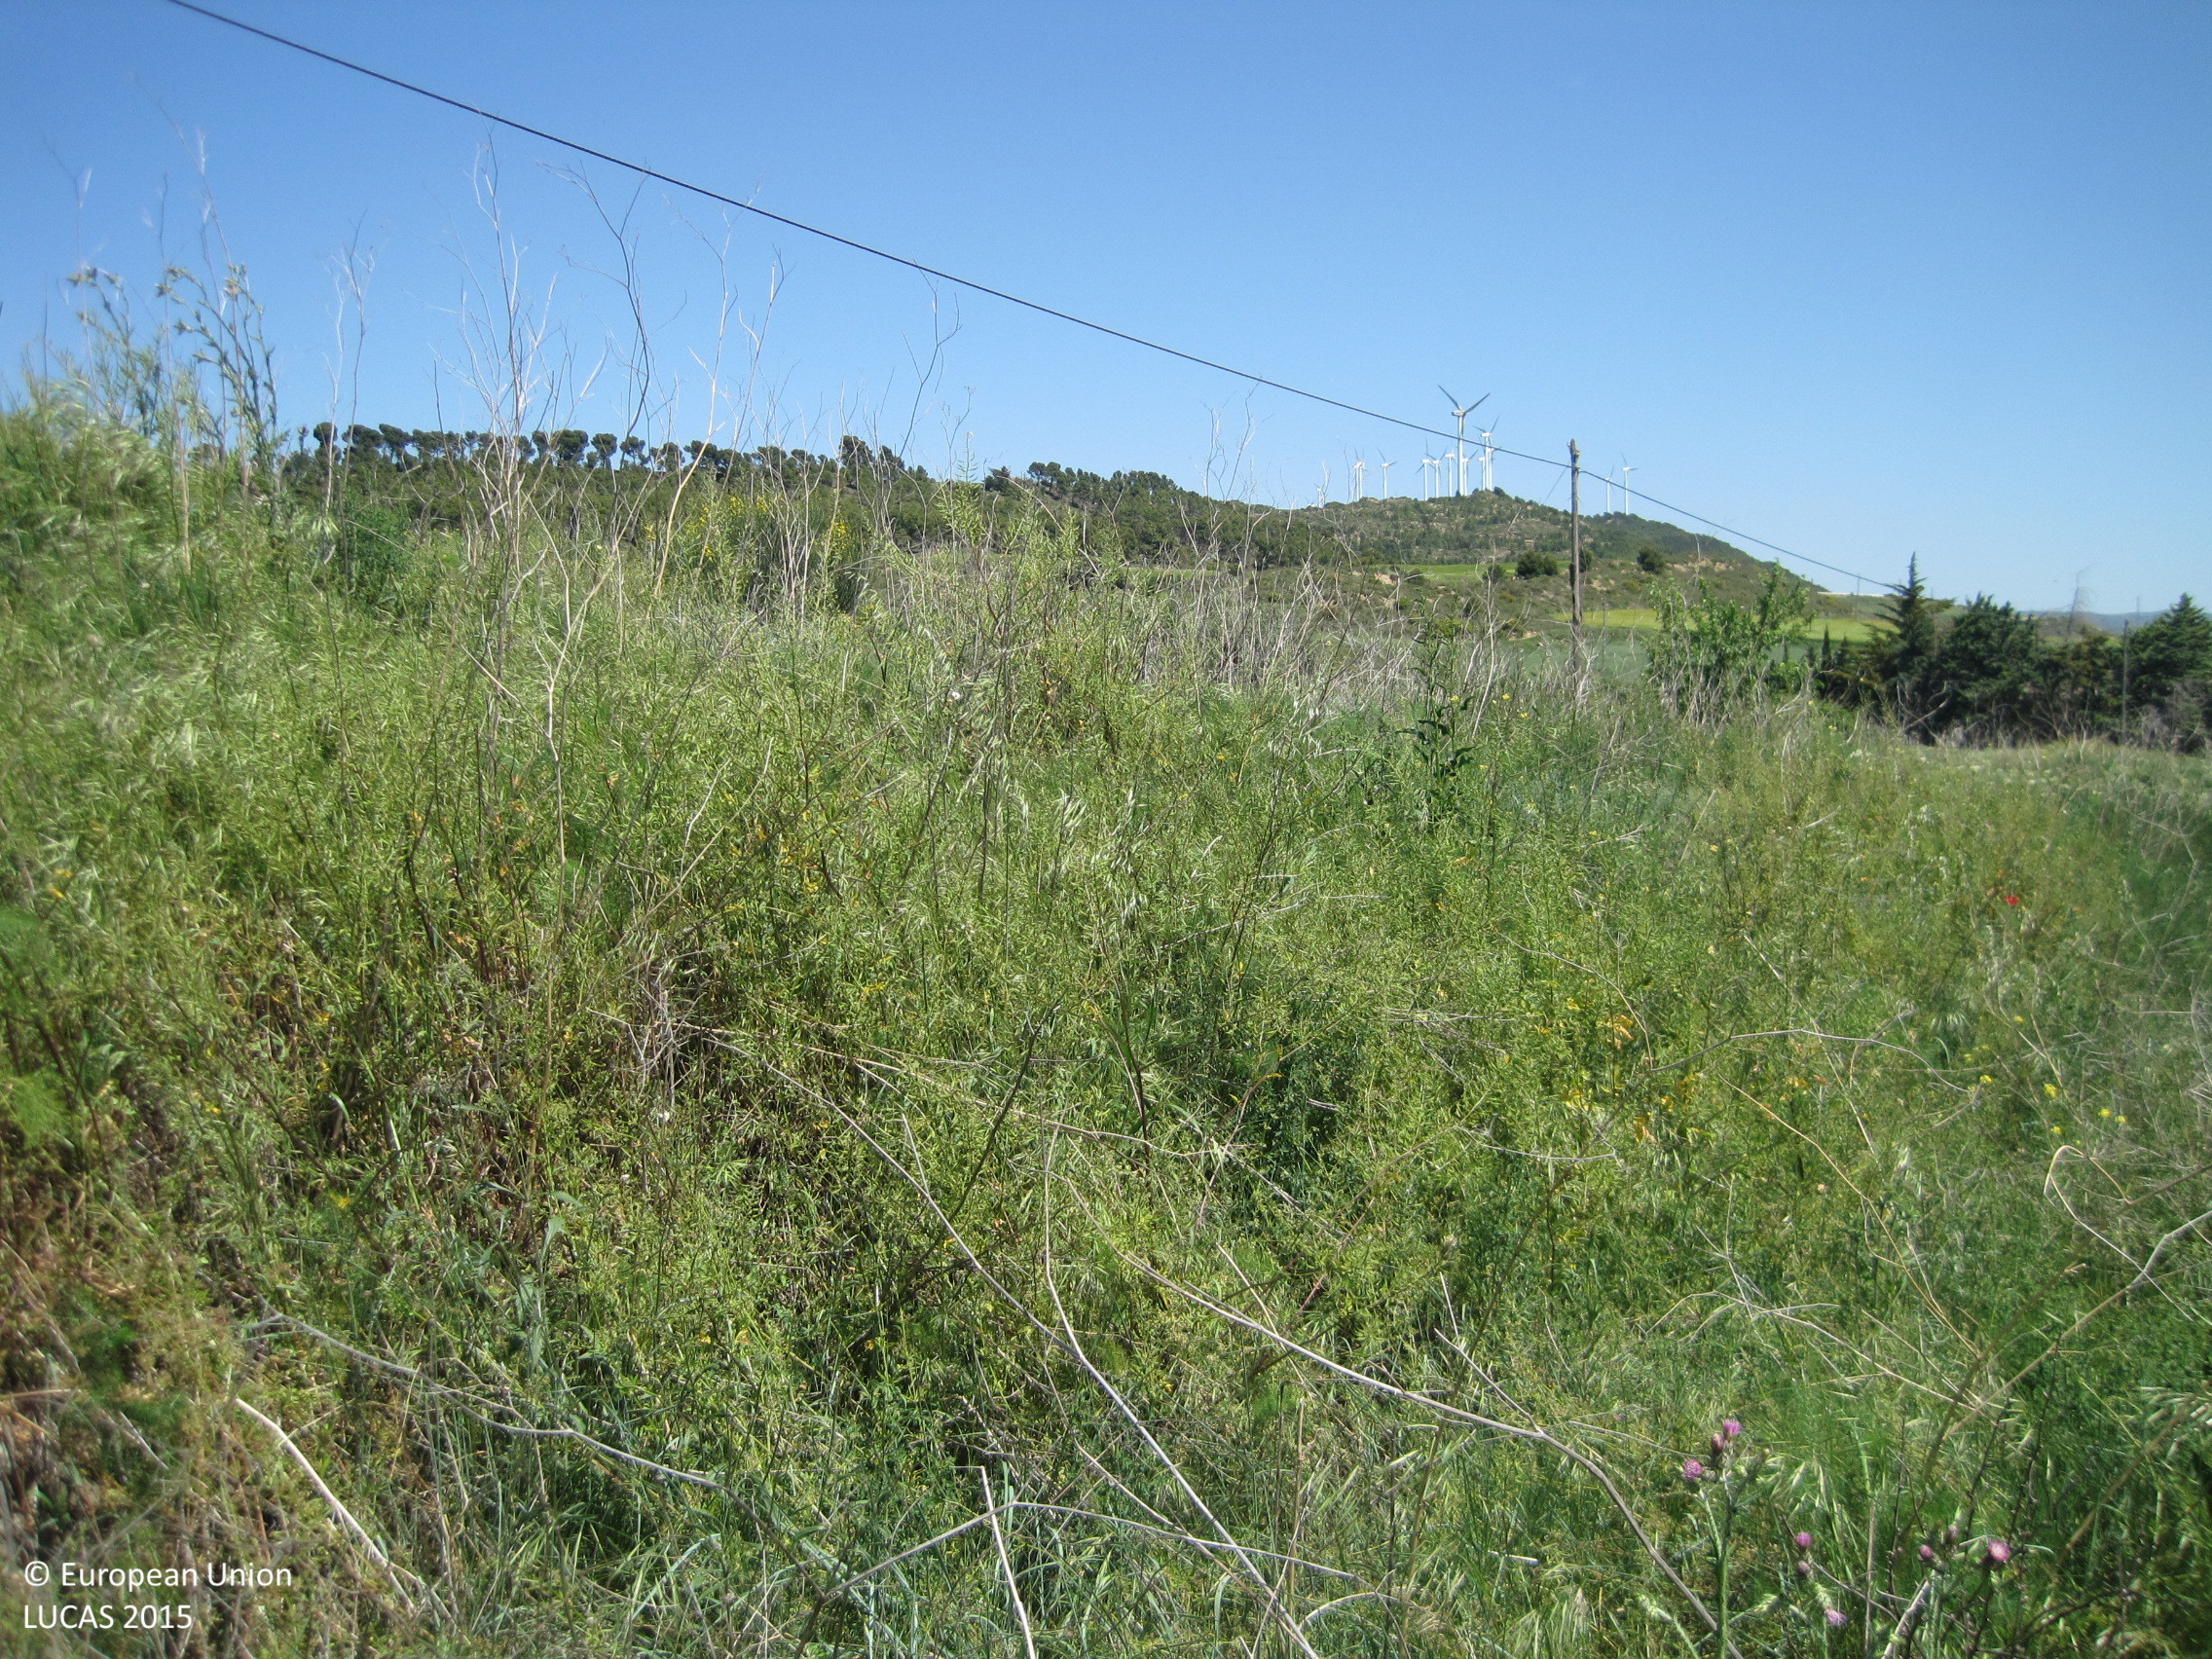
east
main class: Grassland
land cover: Grassland without tree/shrub cover
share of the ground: > 75 %
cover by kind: herbaceous plants 95 %, unconsolidated bare surface 5 %
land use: Semi-natural and natural areas not in use
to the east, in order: Grassland without tree/shrub cover; Electric lines; Grassland without tree/shrub cover; Paved roads, cycling and walking lanes; Grass margins; Common wheat; Olive groves; Grass margins; Common wheat; Electric lines; Common wheat; Grass margins; Ditches and canals; Grass margins; Barley; Common wheat; Electric lines; Common wheat; Shrubland without tree cover; Common wheat
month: May
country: ES
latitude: 42.5247
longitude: -1.6622
